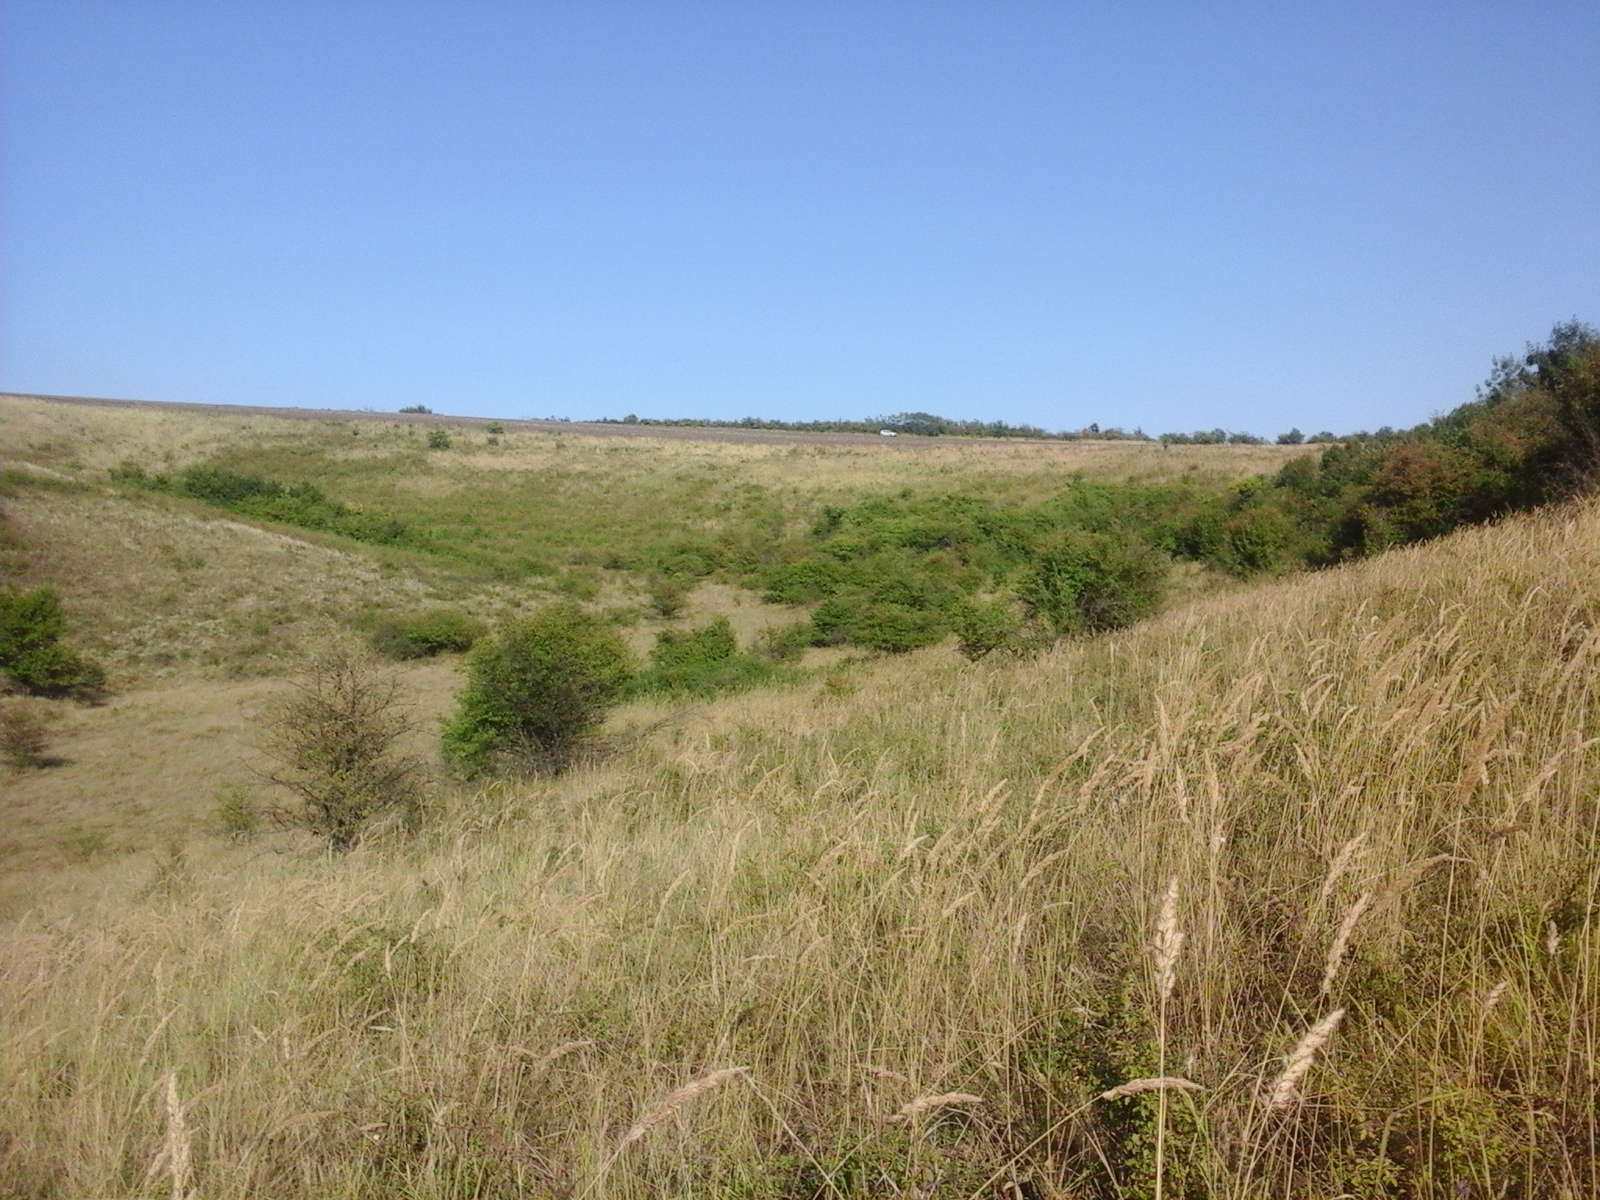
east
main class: Grassland
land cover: Grassland with sparse tree/shrub cover
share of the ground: > 75 %
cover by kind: herbaceous plants 95 %, broadleaved forest trees 5 %
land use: Agriculture (excluding fallow land and kitchen gardens)
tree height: < 5 m
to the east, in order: Grassland with sparse tree/shrub cover; Broadleaved woodland; Shrubland with sparse tree cover
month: August
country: RO
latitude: 45.2928
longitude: 21.4941
